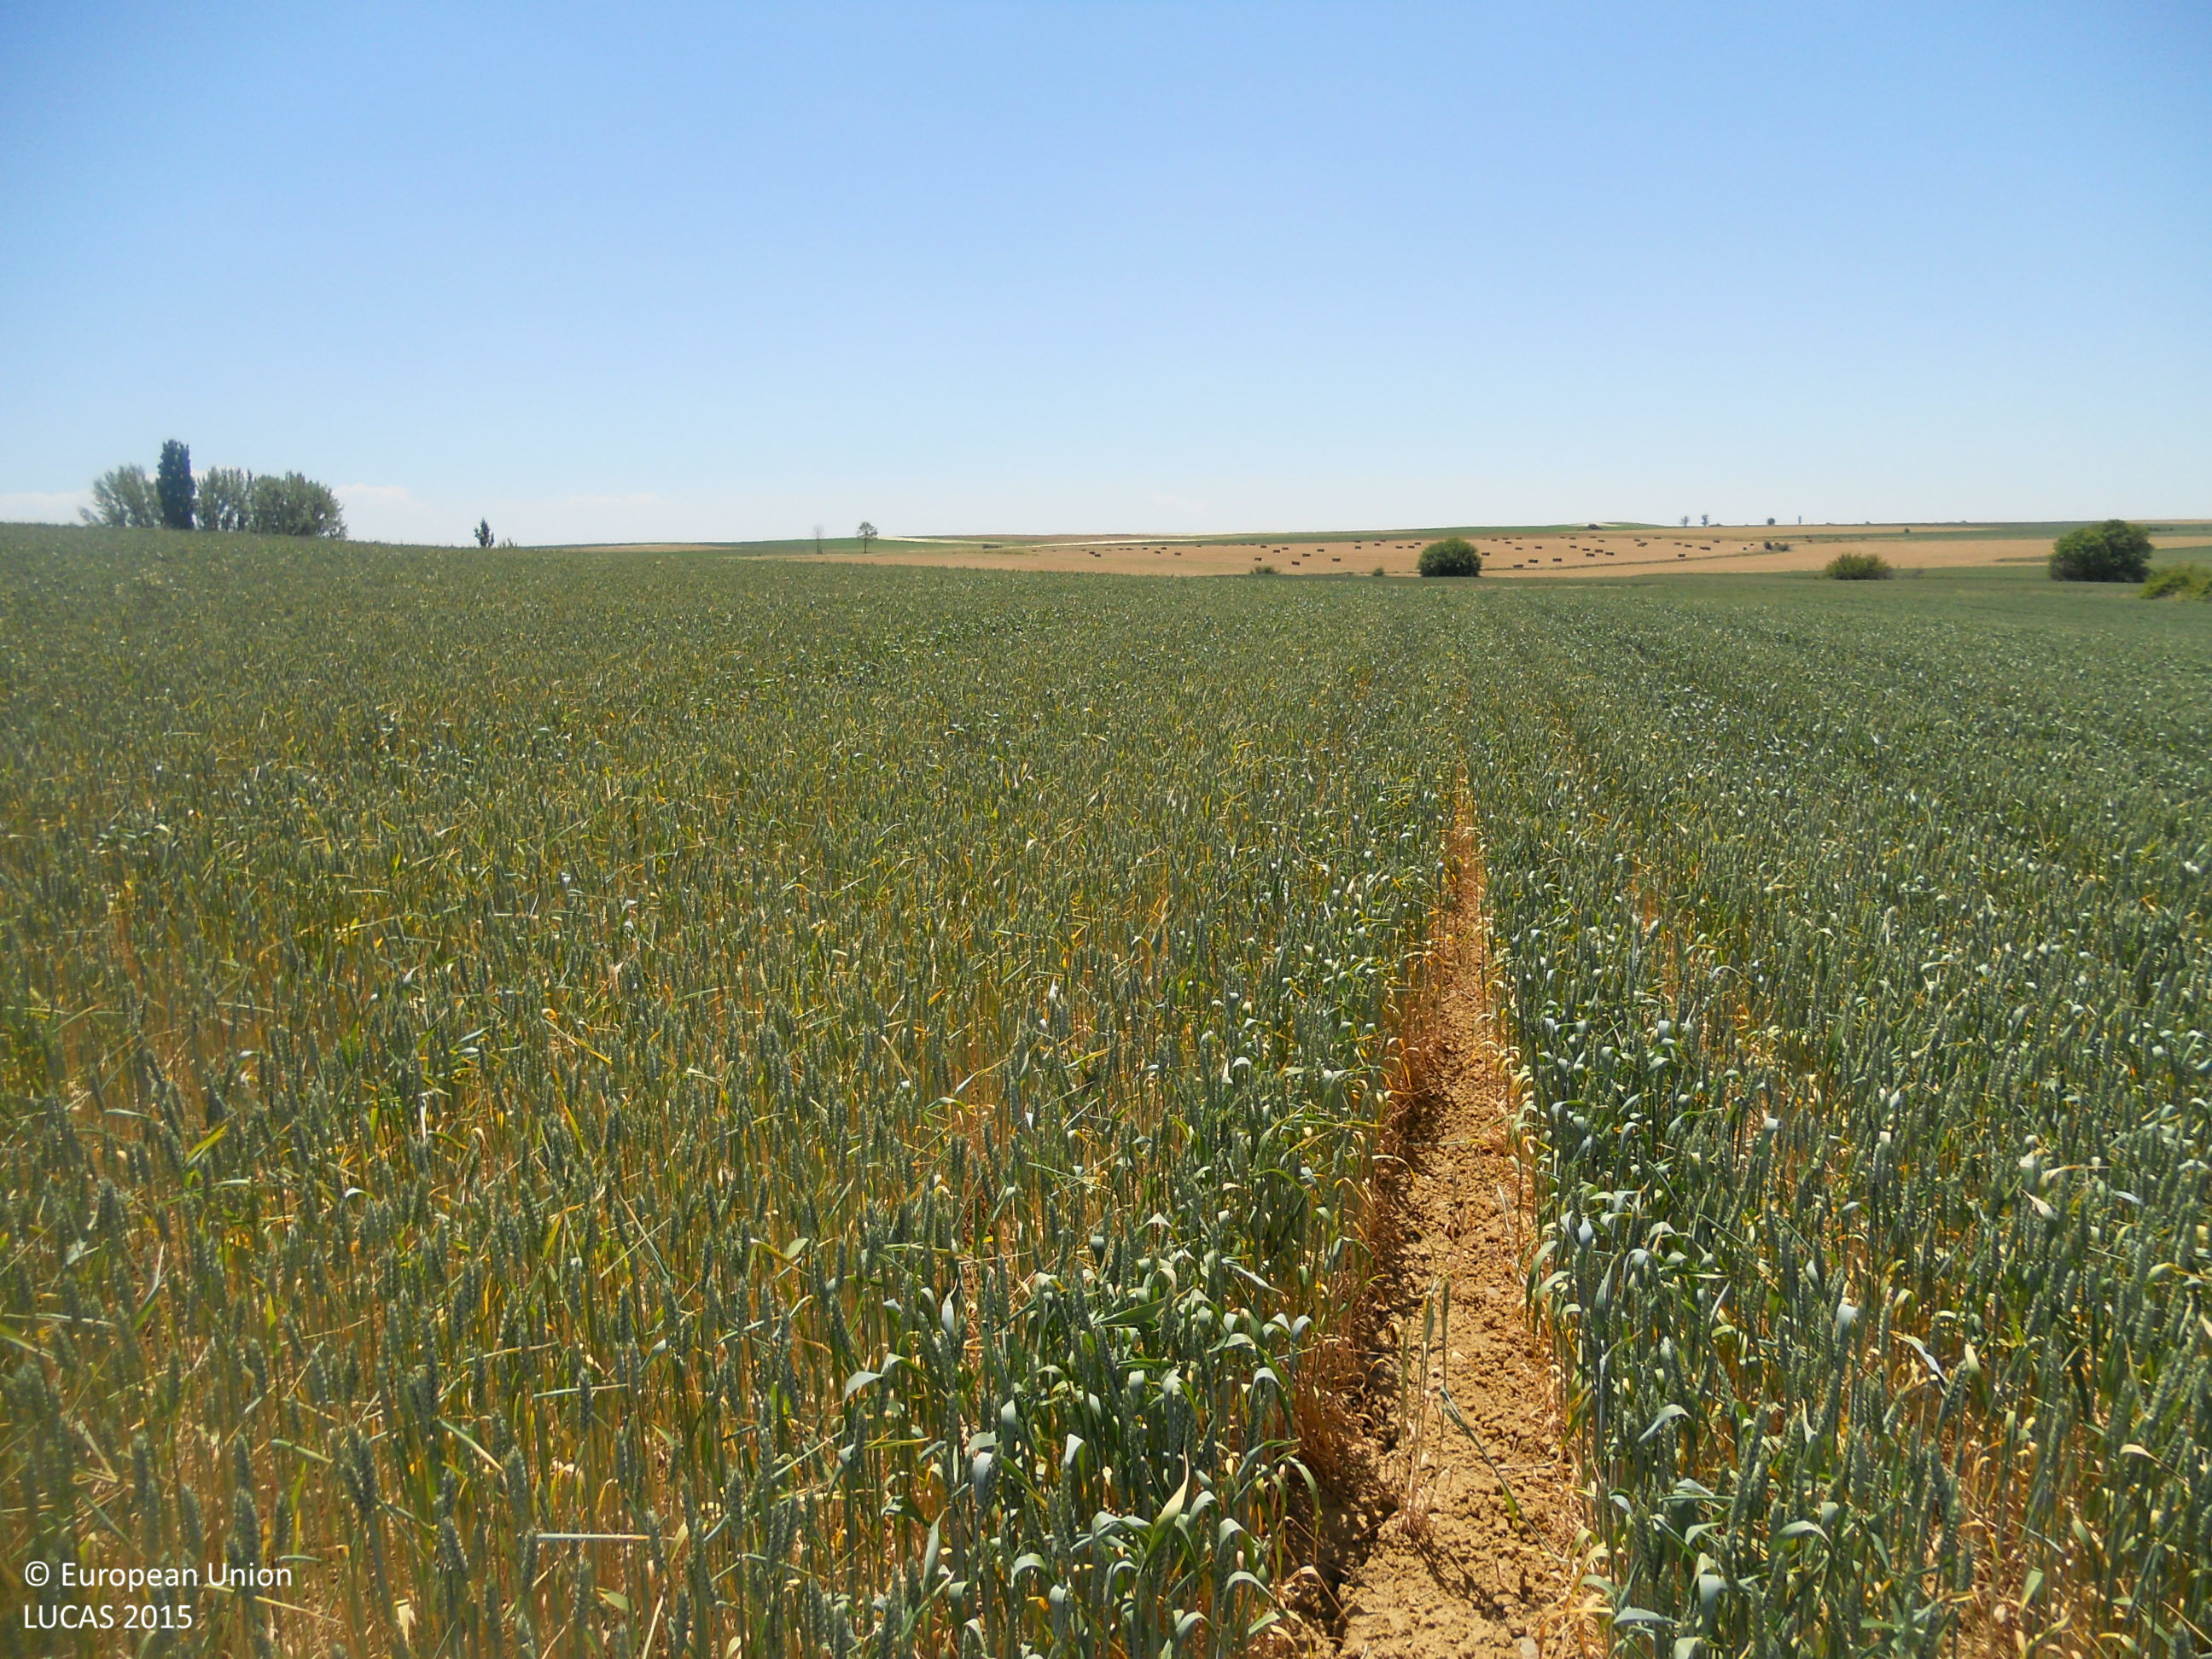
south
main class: Cropland
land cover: Common wheat
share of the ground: > 75 %
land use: Agriculture (excluding fallow land and kitchen gardens)
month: May
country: ES
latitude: 42.2803
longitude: -4.7623
